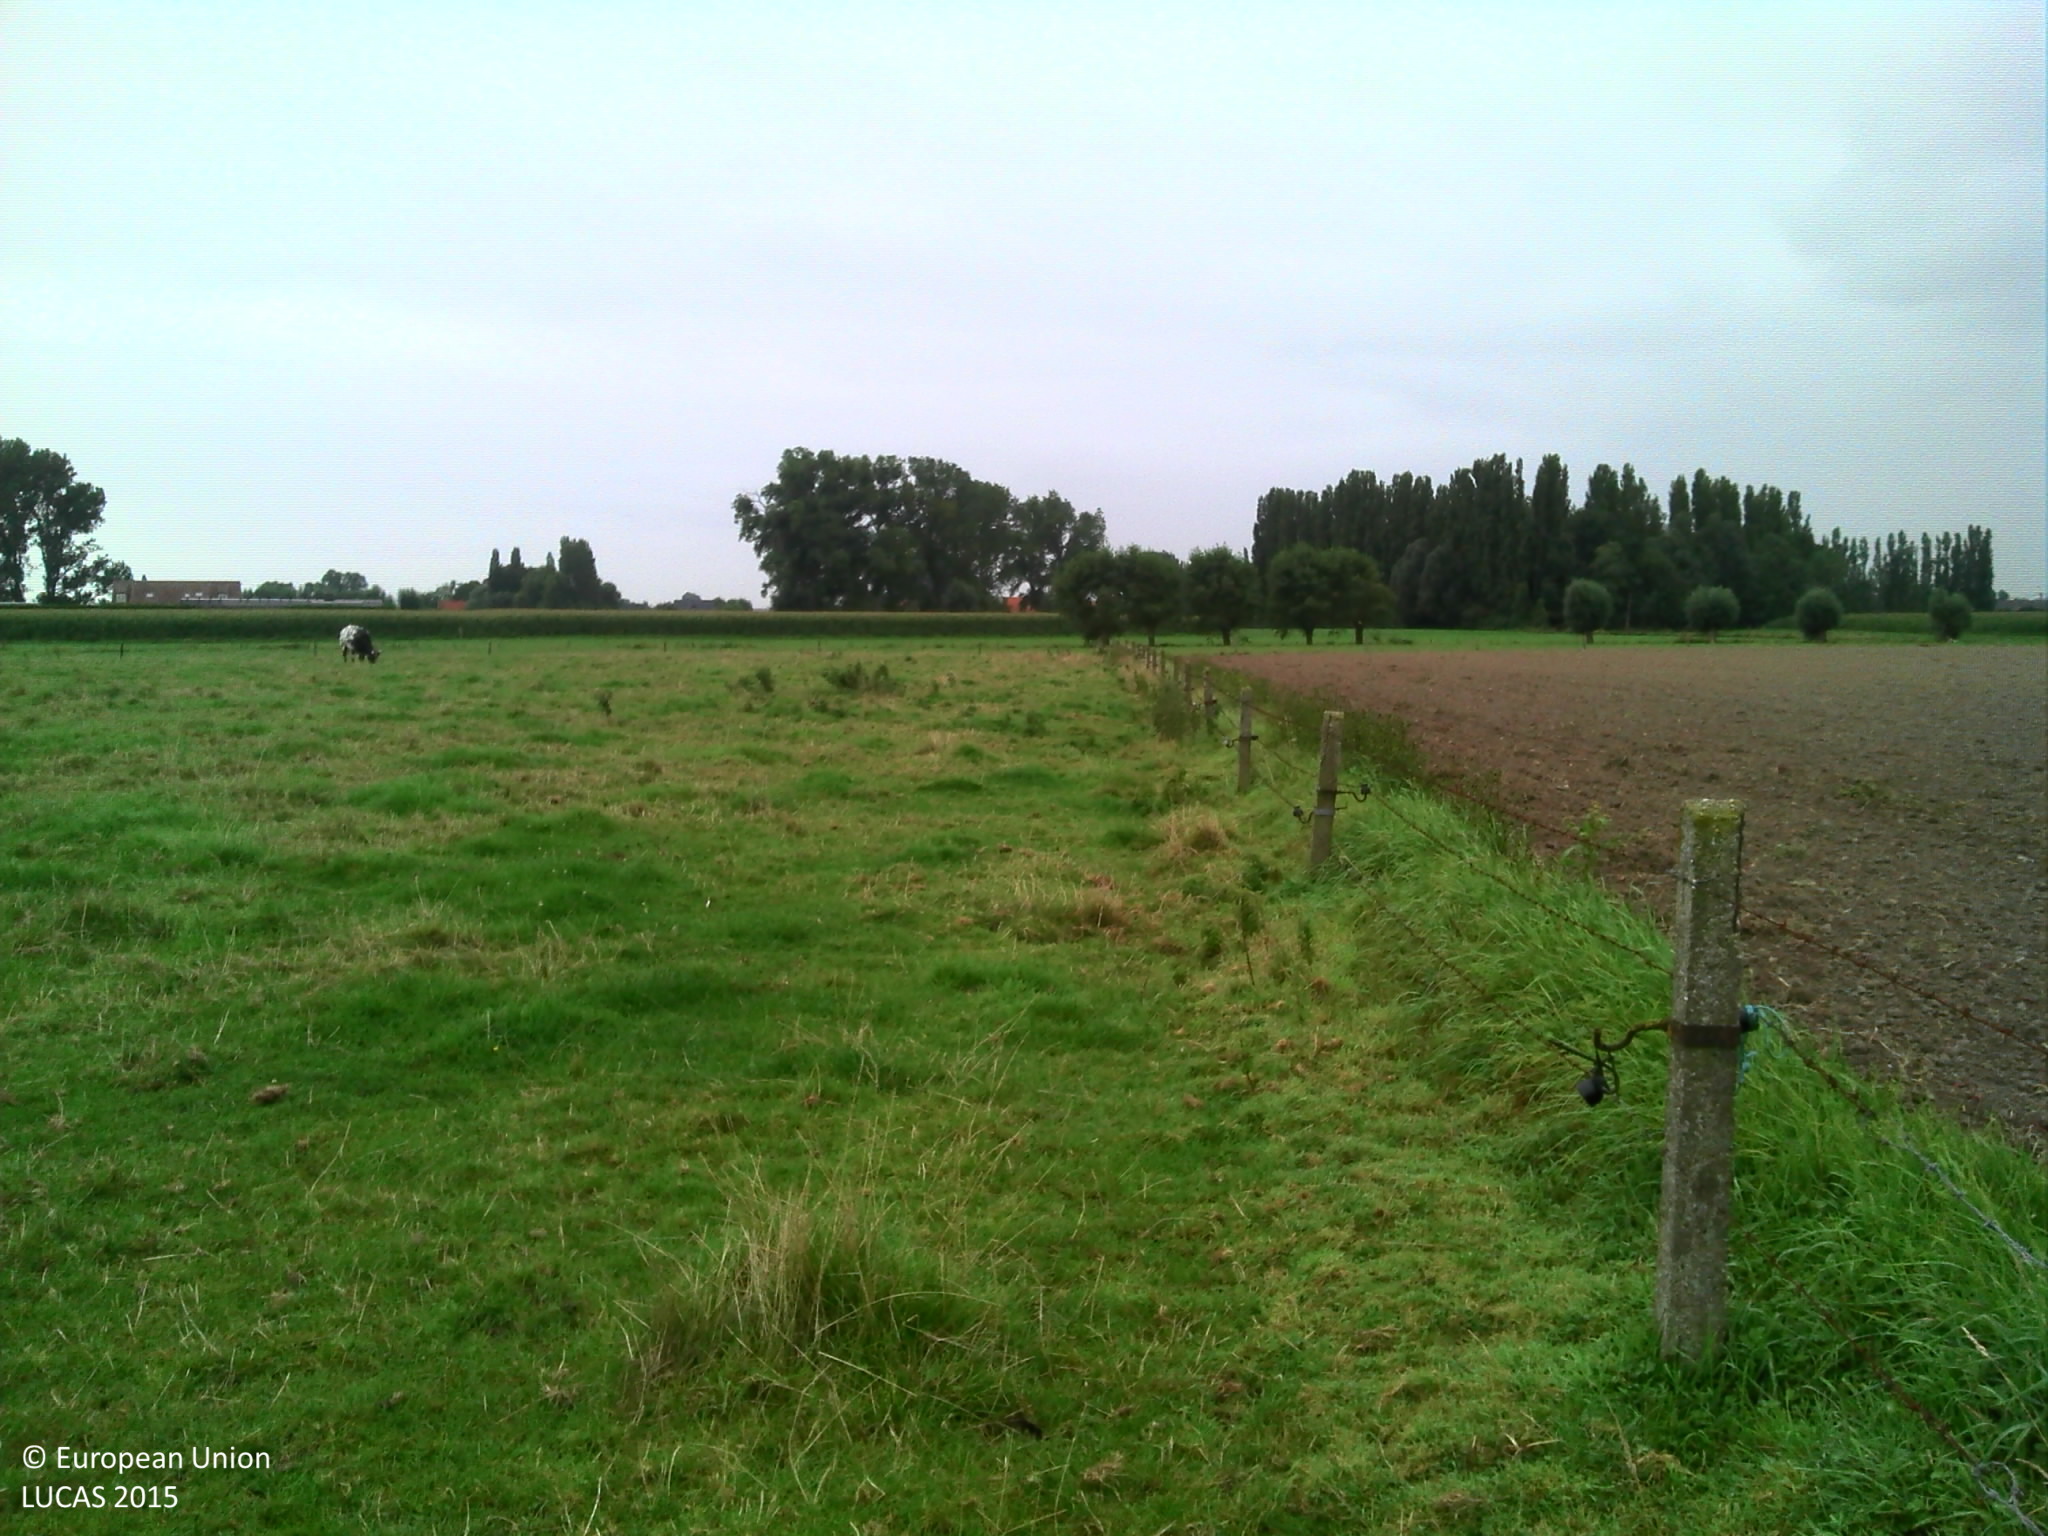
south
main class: Grassland
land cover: Grassland without tree/shrub cover
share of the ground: > 75 %
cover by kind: herbaceous plants 100 %
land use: Agriculture (excluding fallow land and kitchen gardens)
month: September
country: BE
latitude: 51.0403
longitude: 3.4170
